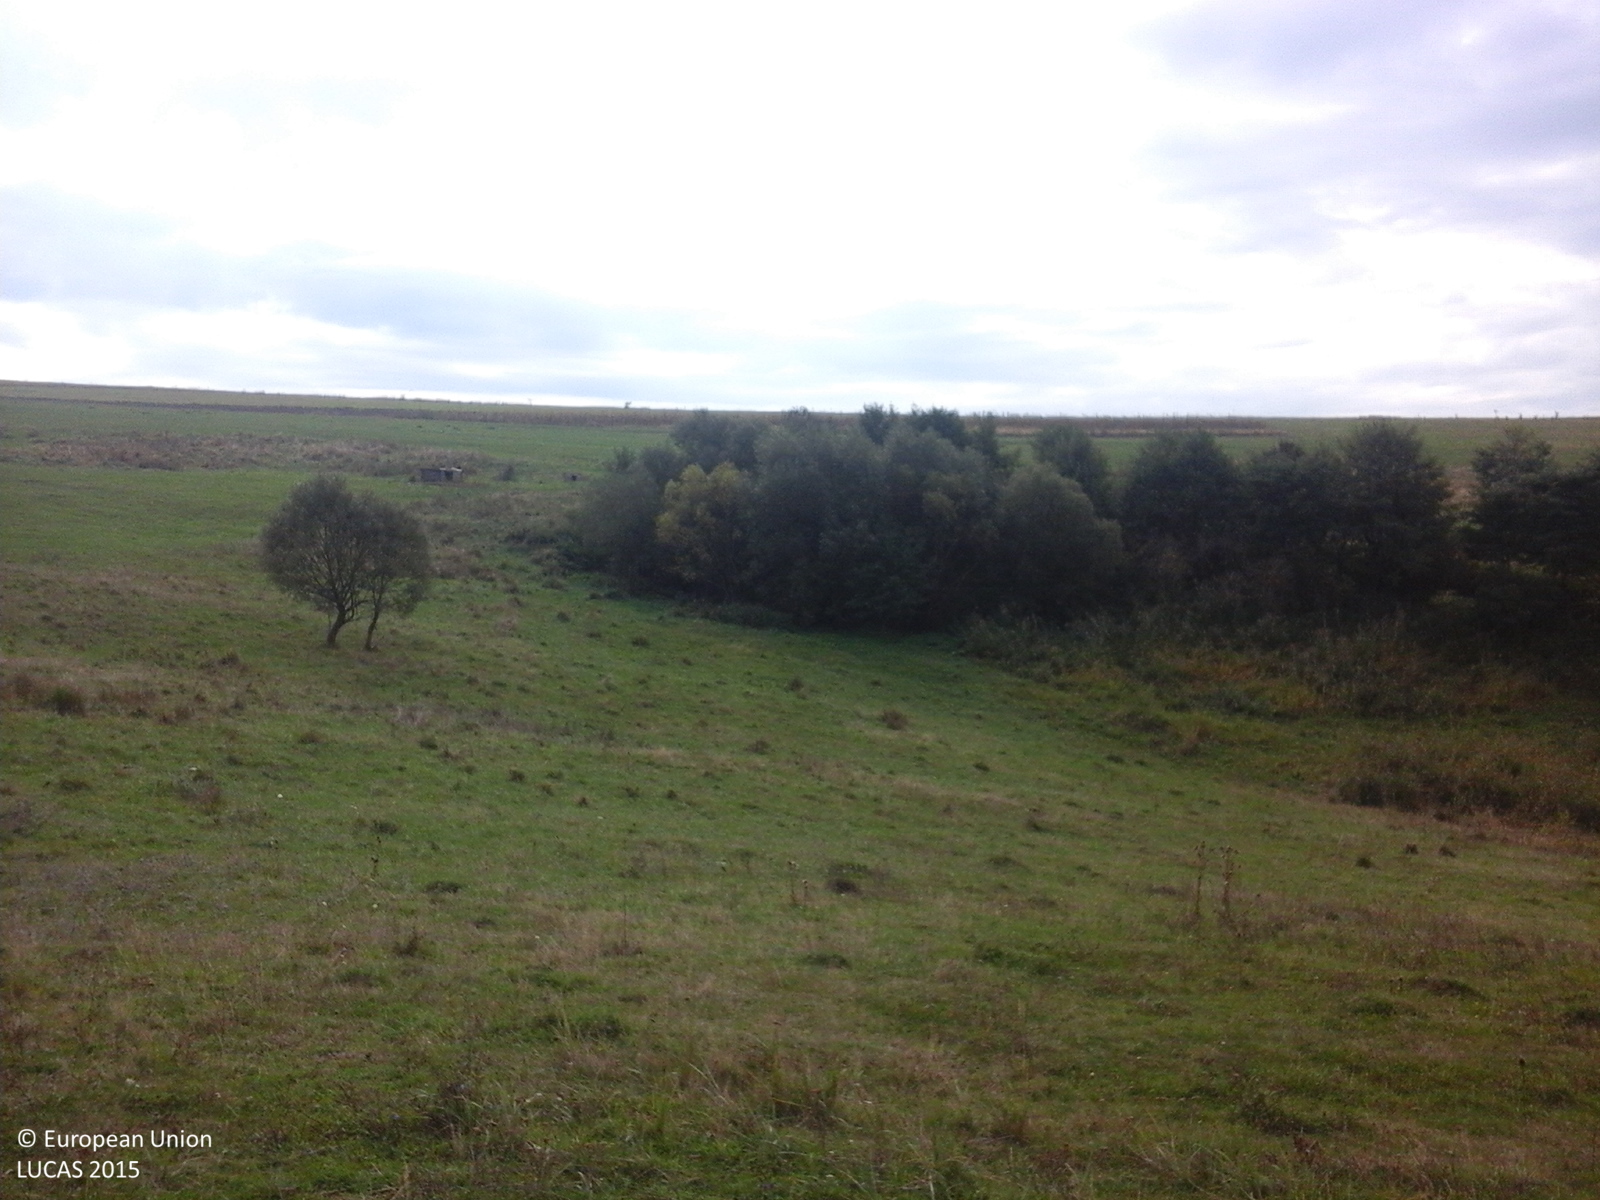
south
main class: Grassland
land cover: Grassland without tree/shrub cover
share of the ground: > 75 %
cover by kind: herbaceous plants 100 %
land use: Agriculture (excluding fallow land and kitchen gardens)
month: October
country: RO
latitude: 46.6581
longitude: 24.8759
